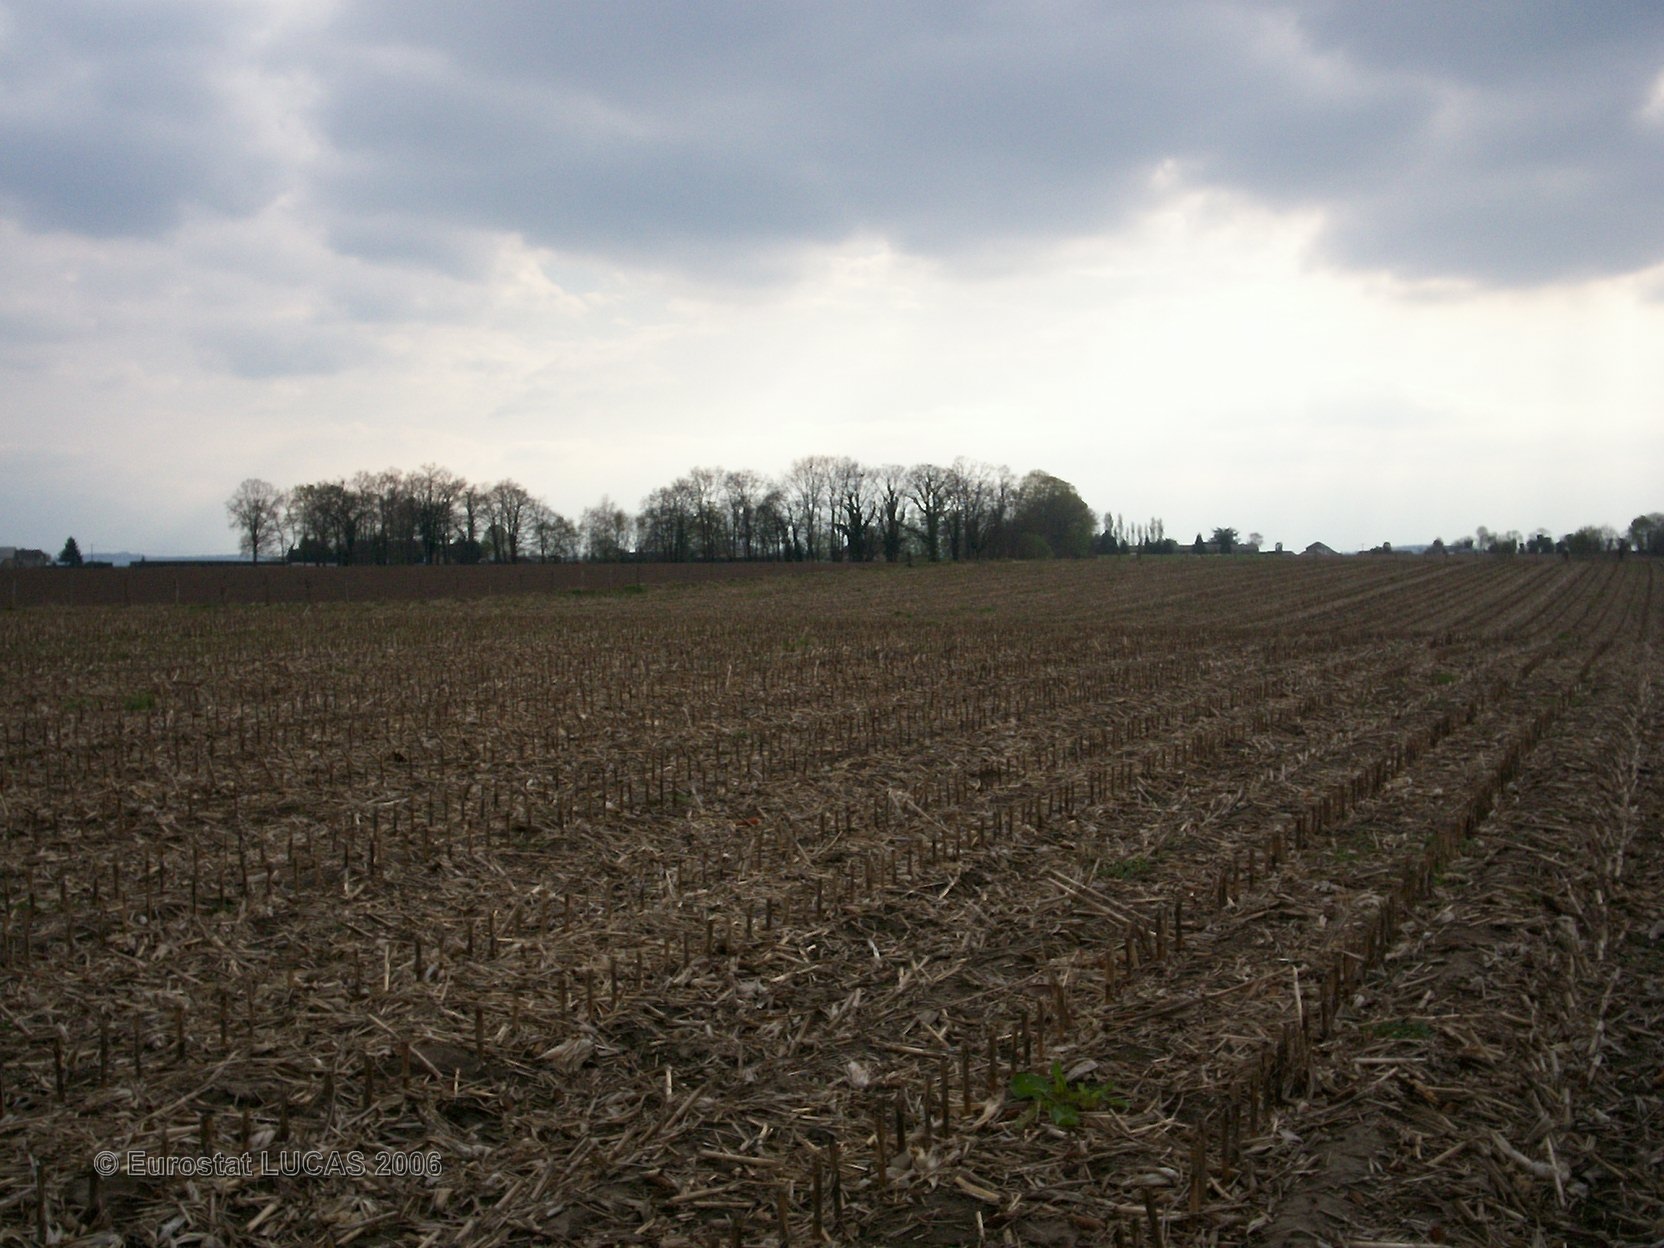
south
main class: Cropland
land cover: Maize
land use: Agriculture (excluding fallow land and kitchen gardens)
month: June
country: FR
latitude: 43.2528
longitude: -0.1419
